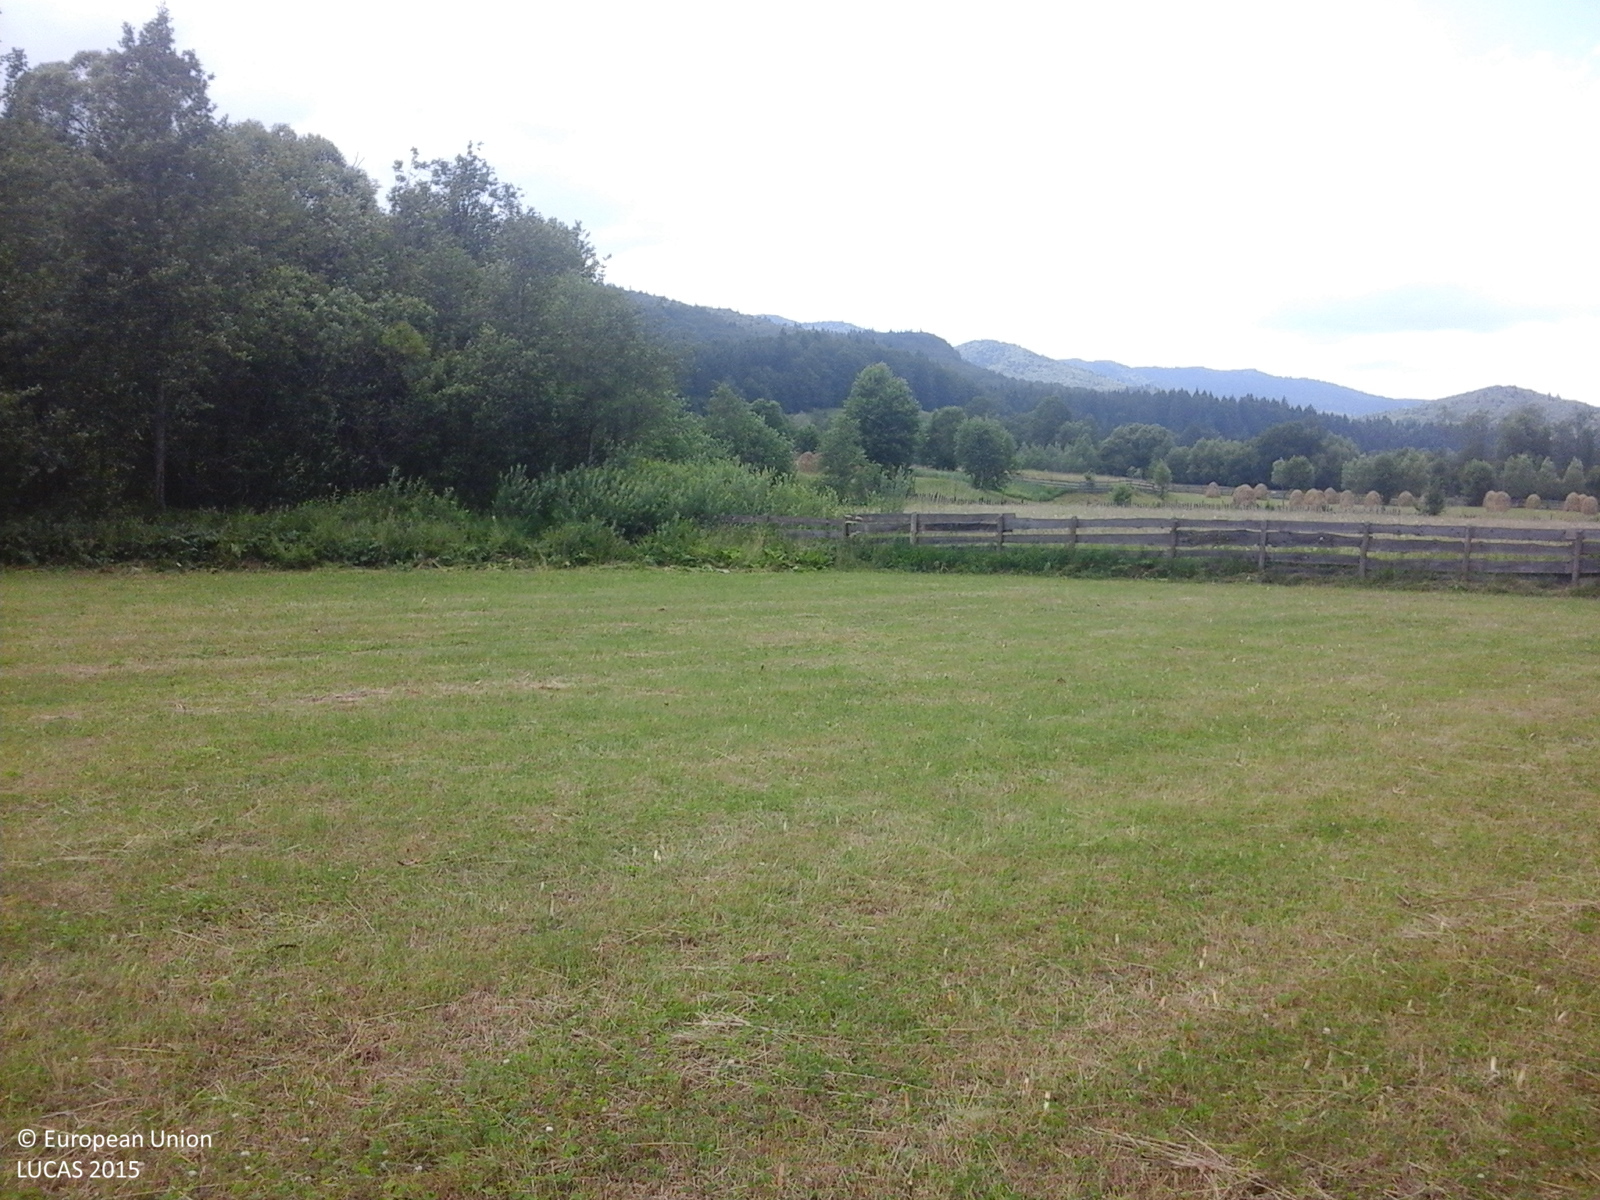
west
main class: Grassland
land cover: Grassland without tree/shrub cover
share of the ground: > 75 %
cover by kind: herbaceous plants 100 %
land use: Agriculture (excluding fallow land and kitchen gardens)
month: June
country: RO
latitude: 47.6228
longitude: 25.8127
